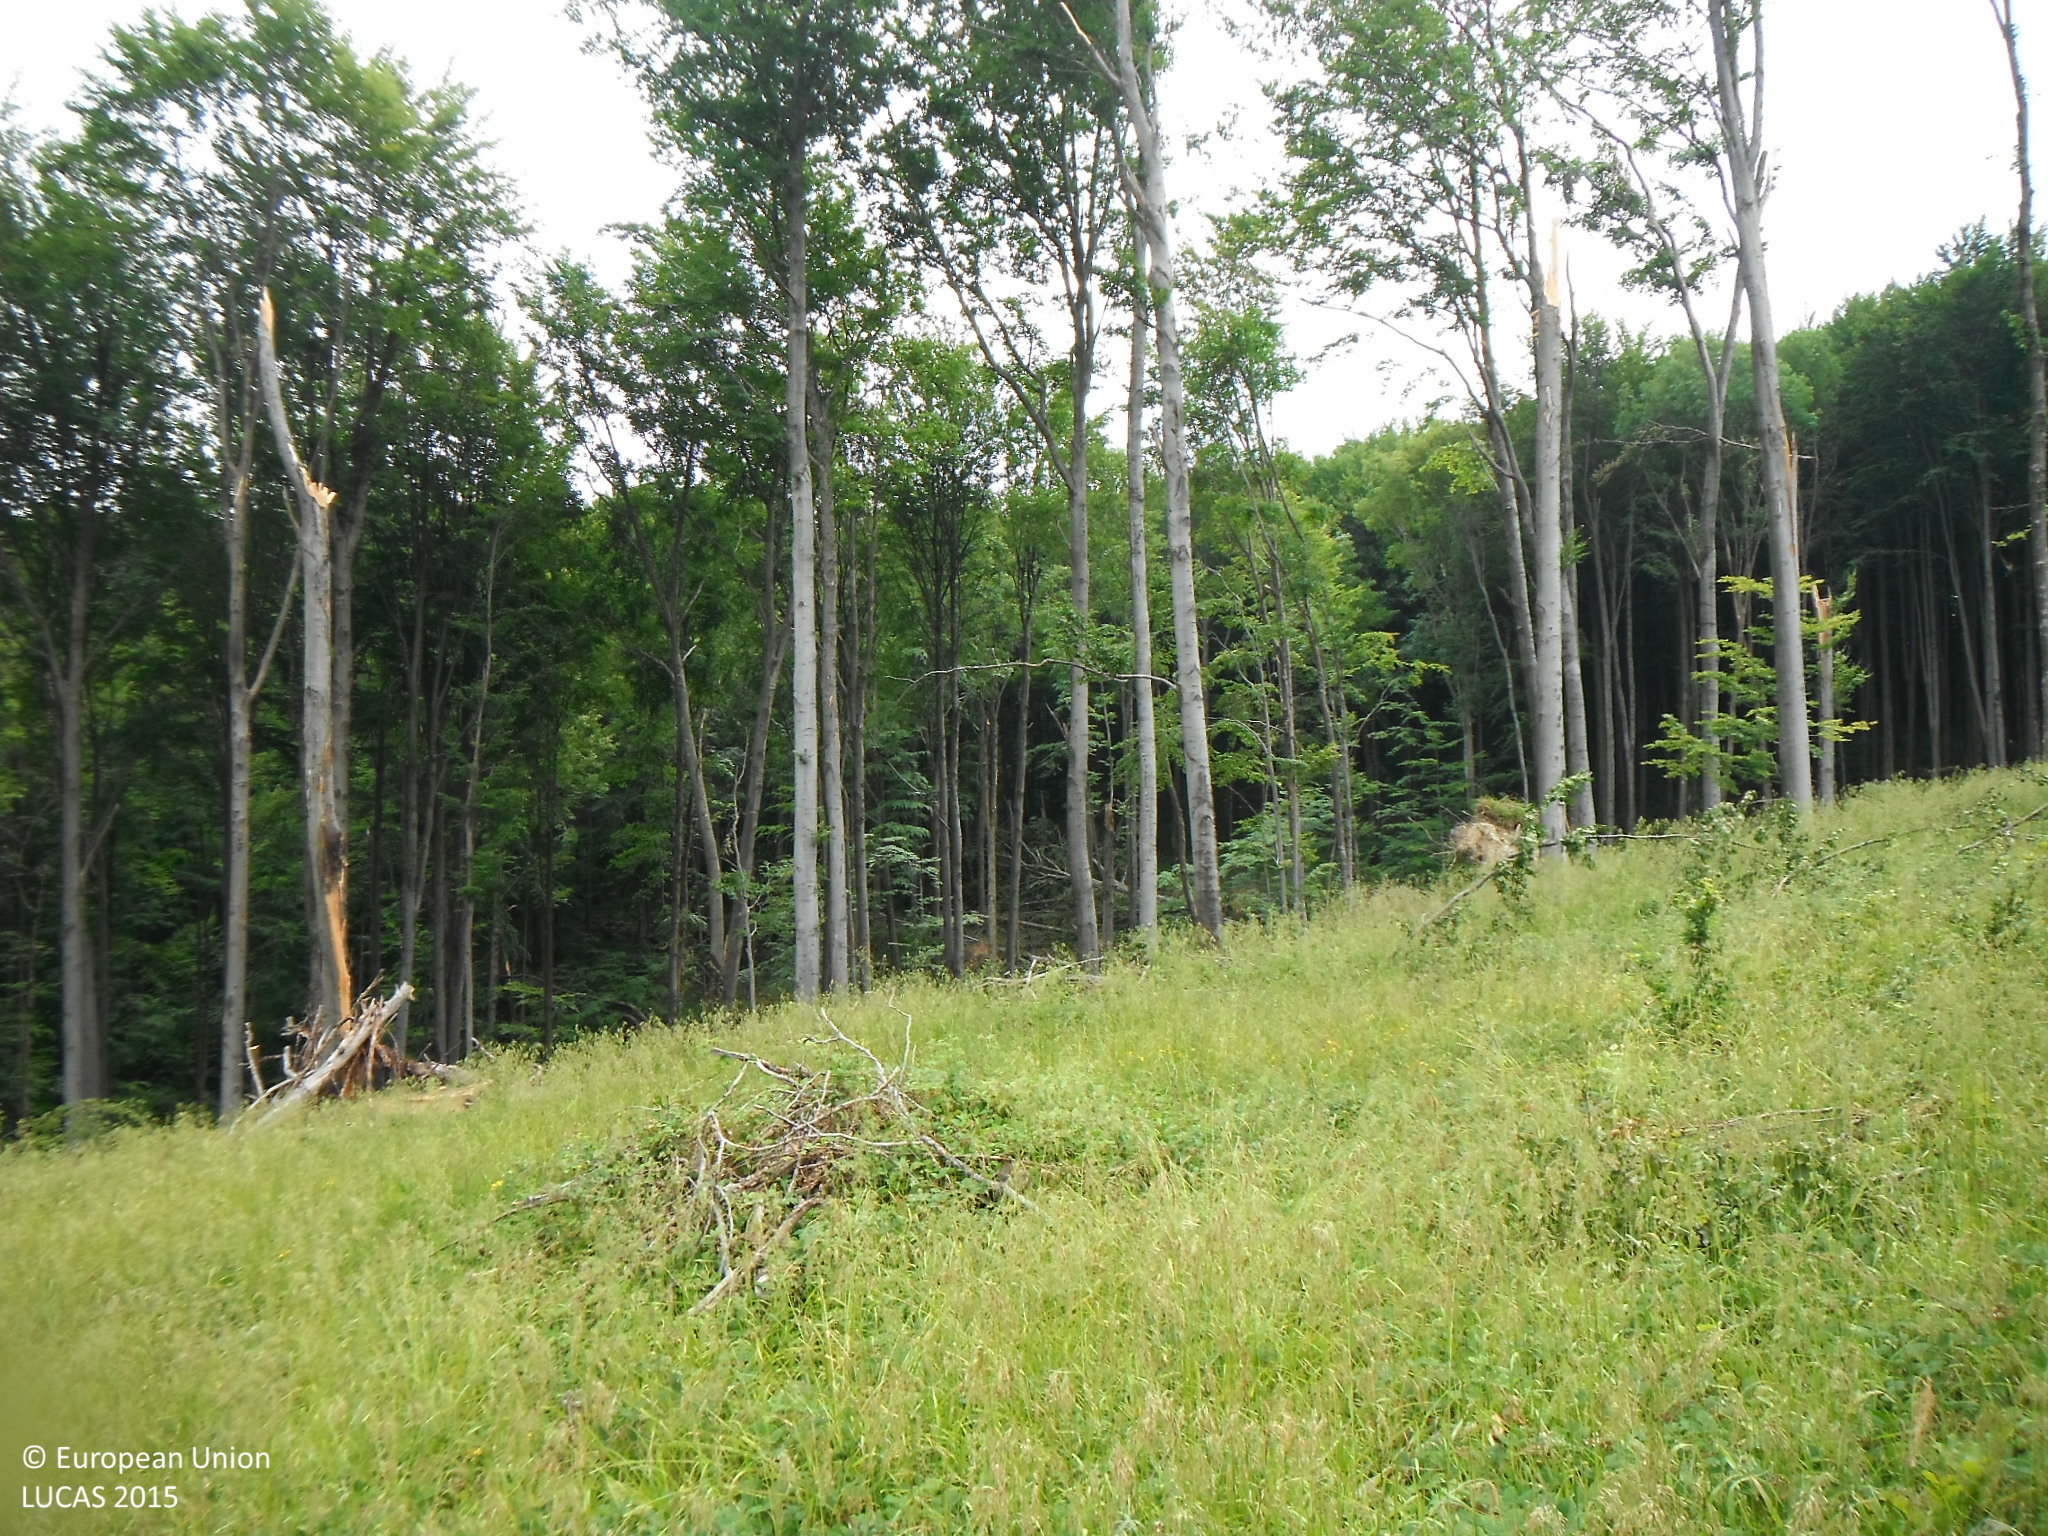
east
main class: Grassland
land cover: Spontaneously vegetated surfaces
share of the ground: > 75 %
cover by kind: herbaceous plants 95 %, shrubs 5 %
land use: Forestry
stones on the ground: 25 - 50 %
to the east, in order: Spontaneously vegetated surfaces; Broadleaved woodland
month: July
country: SK
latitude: 49.3162
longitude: 21.9548
